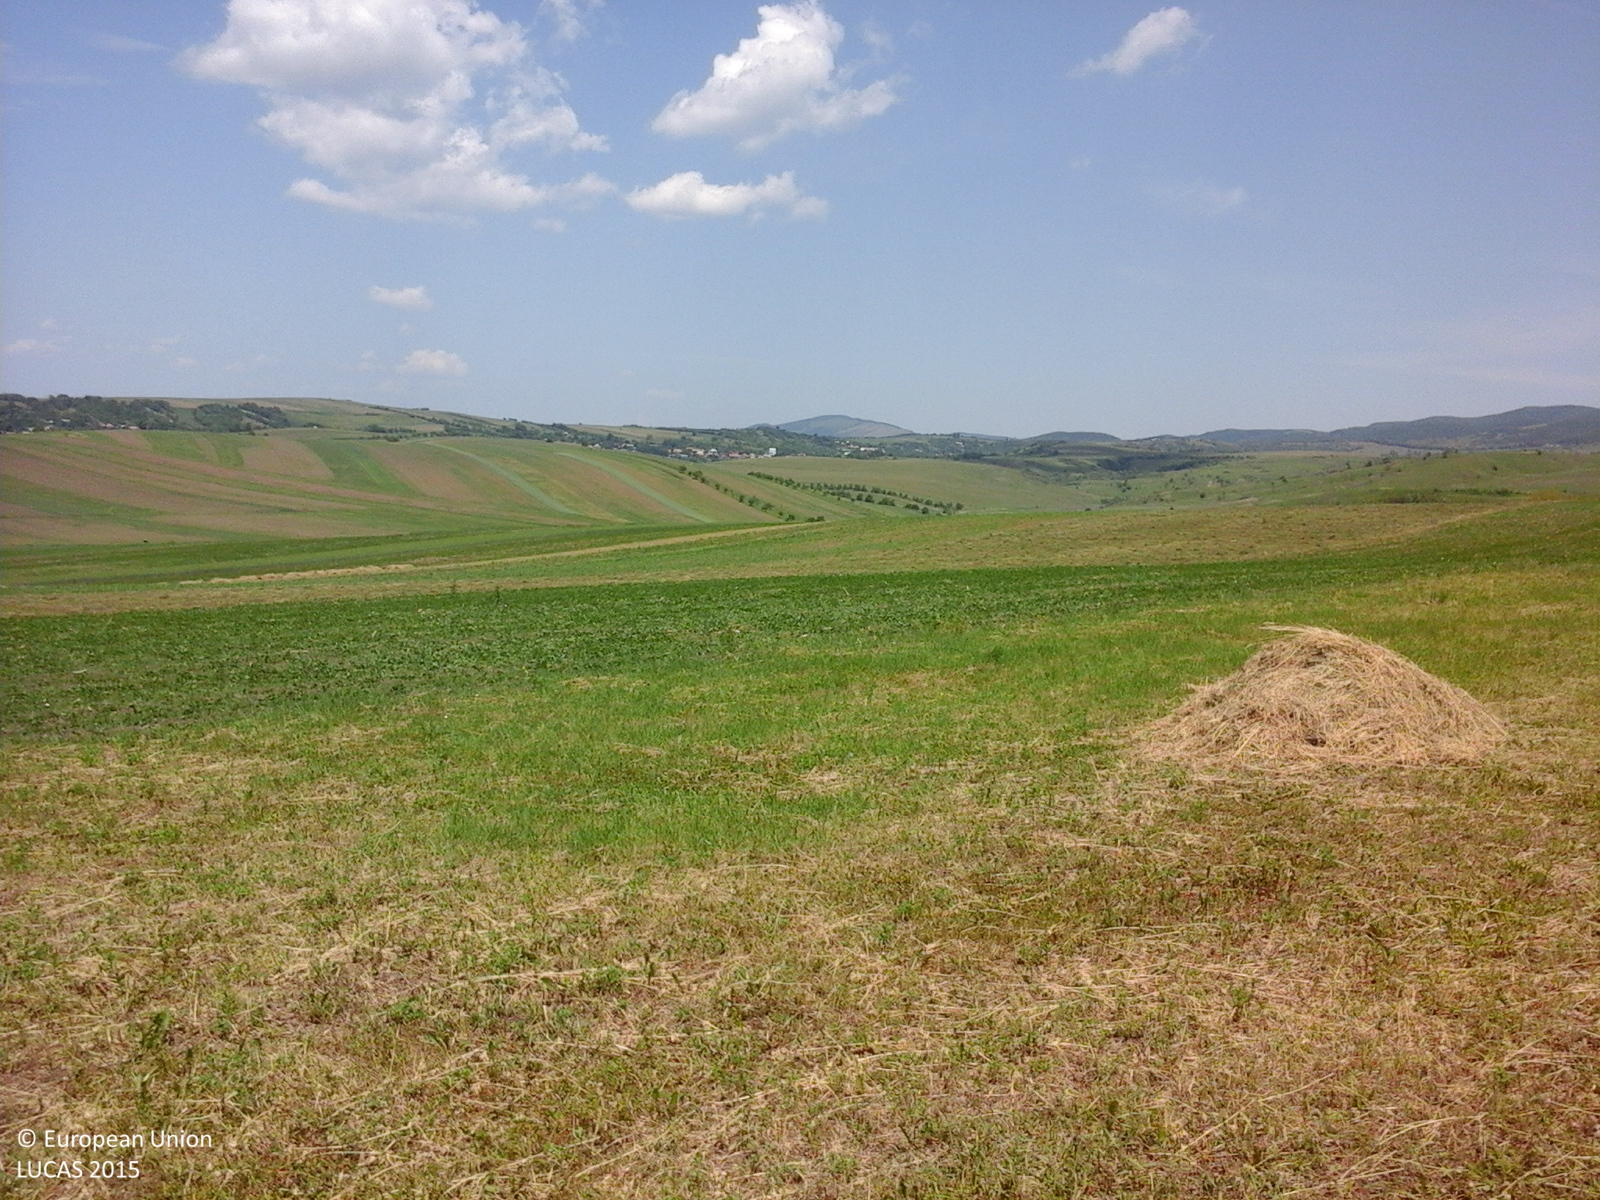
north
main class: Grassland
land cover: Grassland without tree/shrub cover
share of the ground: > 75 %
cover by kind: herbaceous plants 90 %, unconsolidated bare surface 10 %
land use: Agriculture (excluding fallow land and kitchen gardens)
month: June
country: RO
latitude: 46.3015
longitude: 26.7713
